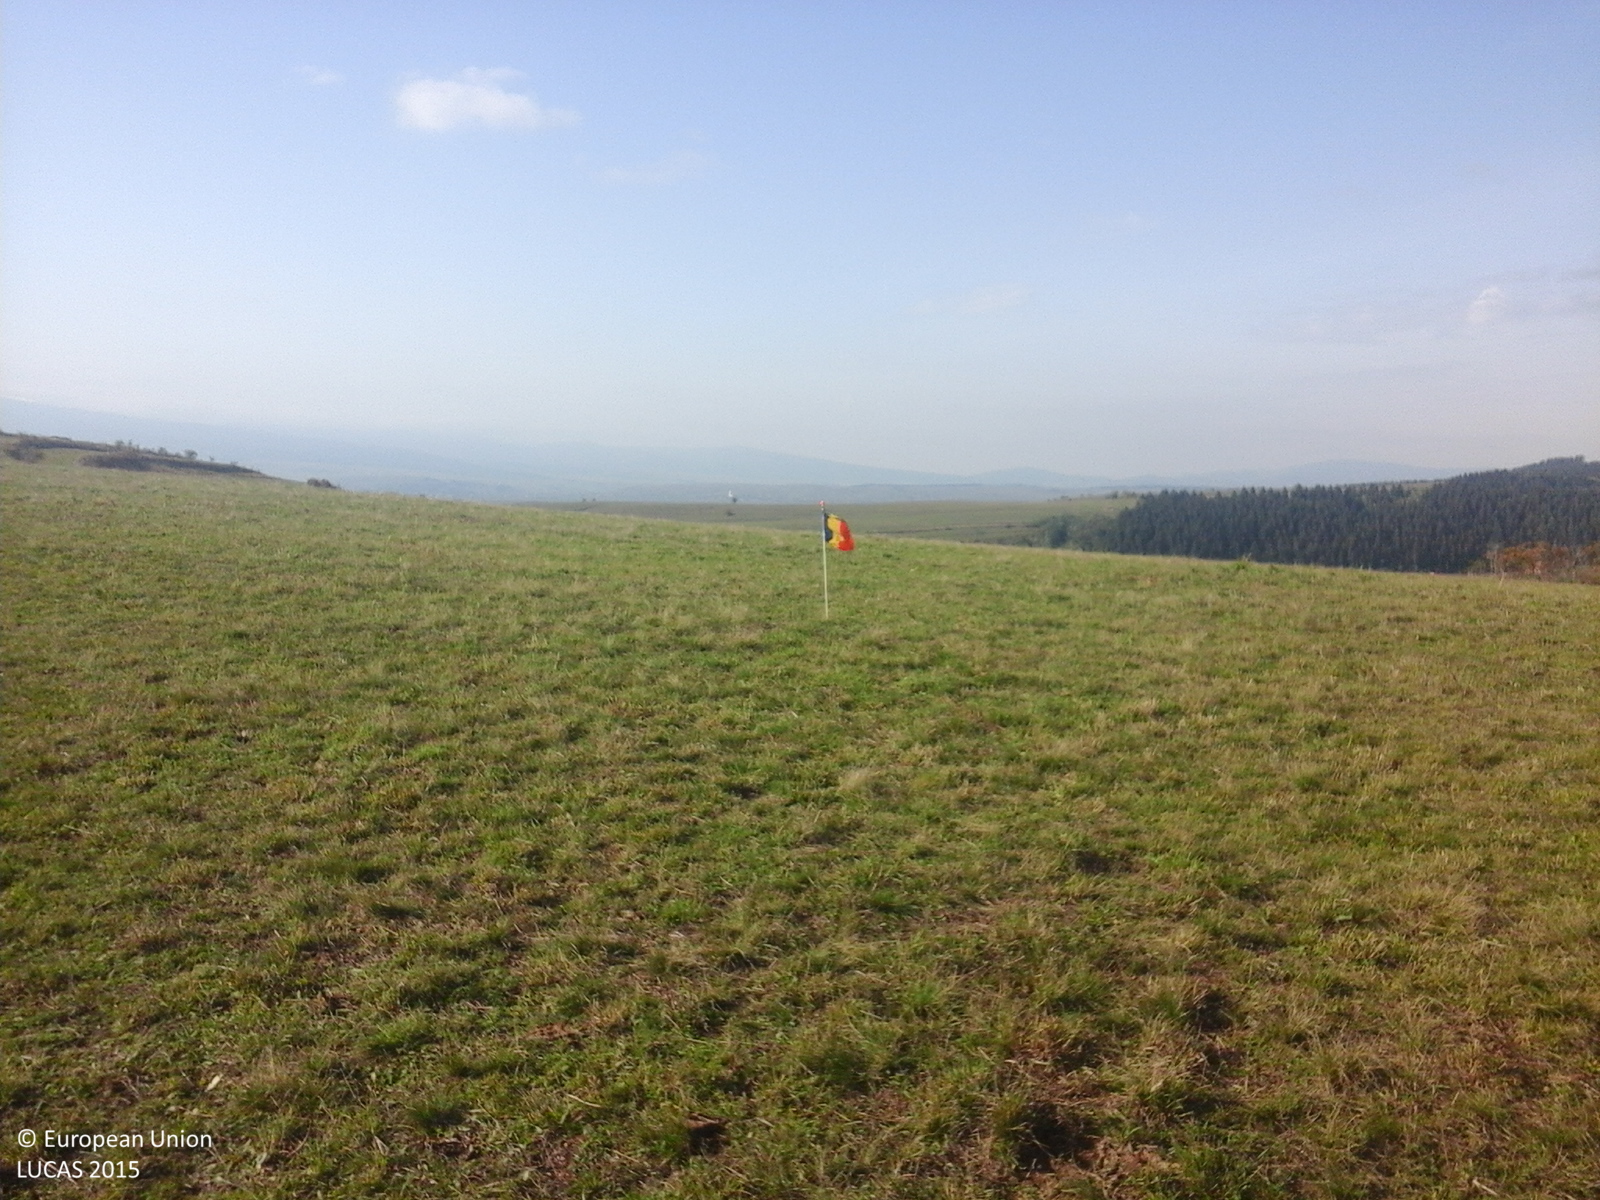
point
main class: Grassland
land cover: Grassland without tree/shrub cover
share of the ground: > 75 %
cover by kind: herbaceous plants 100 %
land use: Agriculture (excluding fallow land and kitchen gardens)
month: October
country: RO
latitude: 46.3867
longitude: 25.8637
